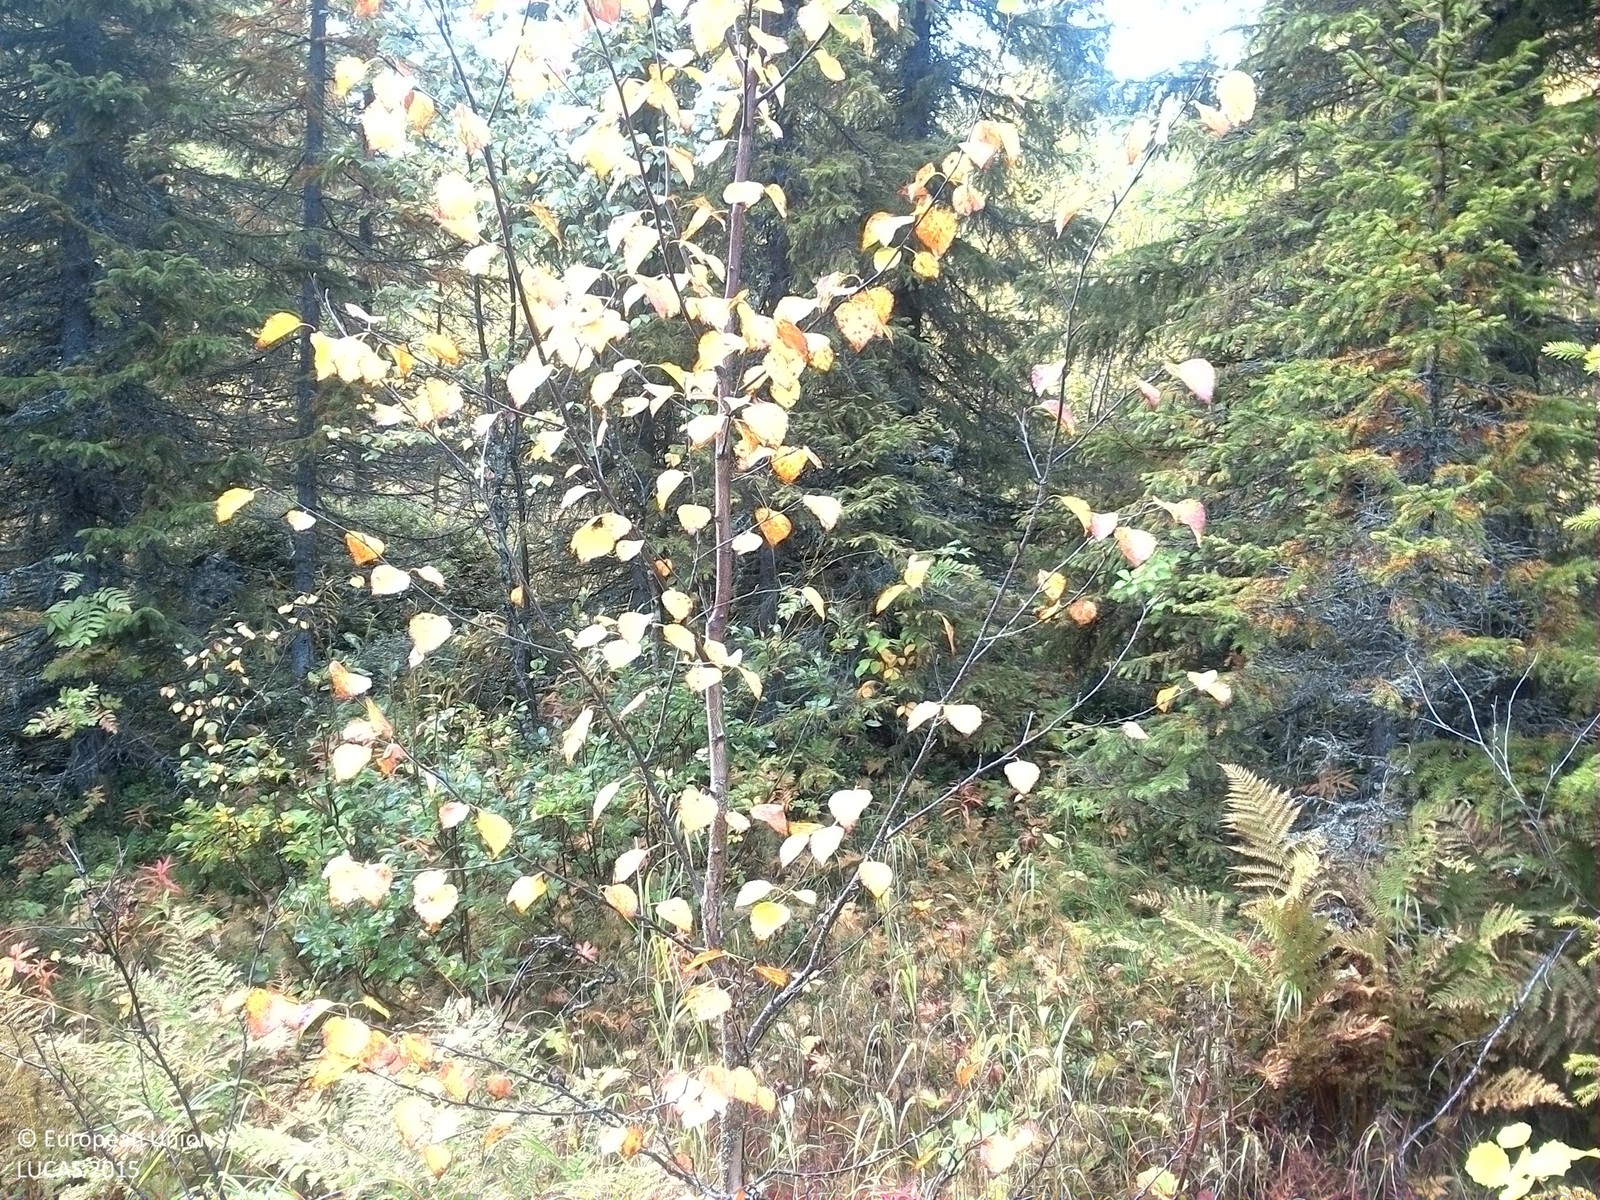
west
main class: Woodland
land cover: Spruce dominated mixed woodland
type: boreal forest
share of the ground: > 75 %
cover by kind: coniferous forest trees 55 %, broadleaved forest trees 20 %, herbaceous plants 15 %, shrubs 5 %, lichens and mosses 5 %
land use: Forestry
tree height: > 5 m
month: September
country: SE
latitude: 63.5817
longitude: 15.9169
